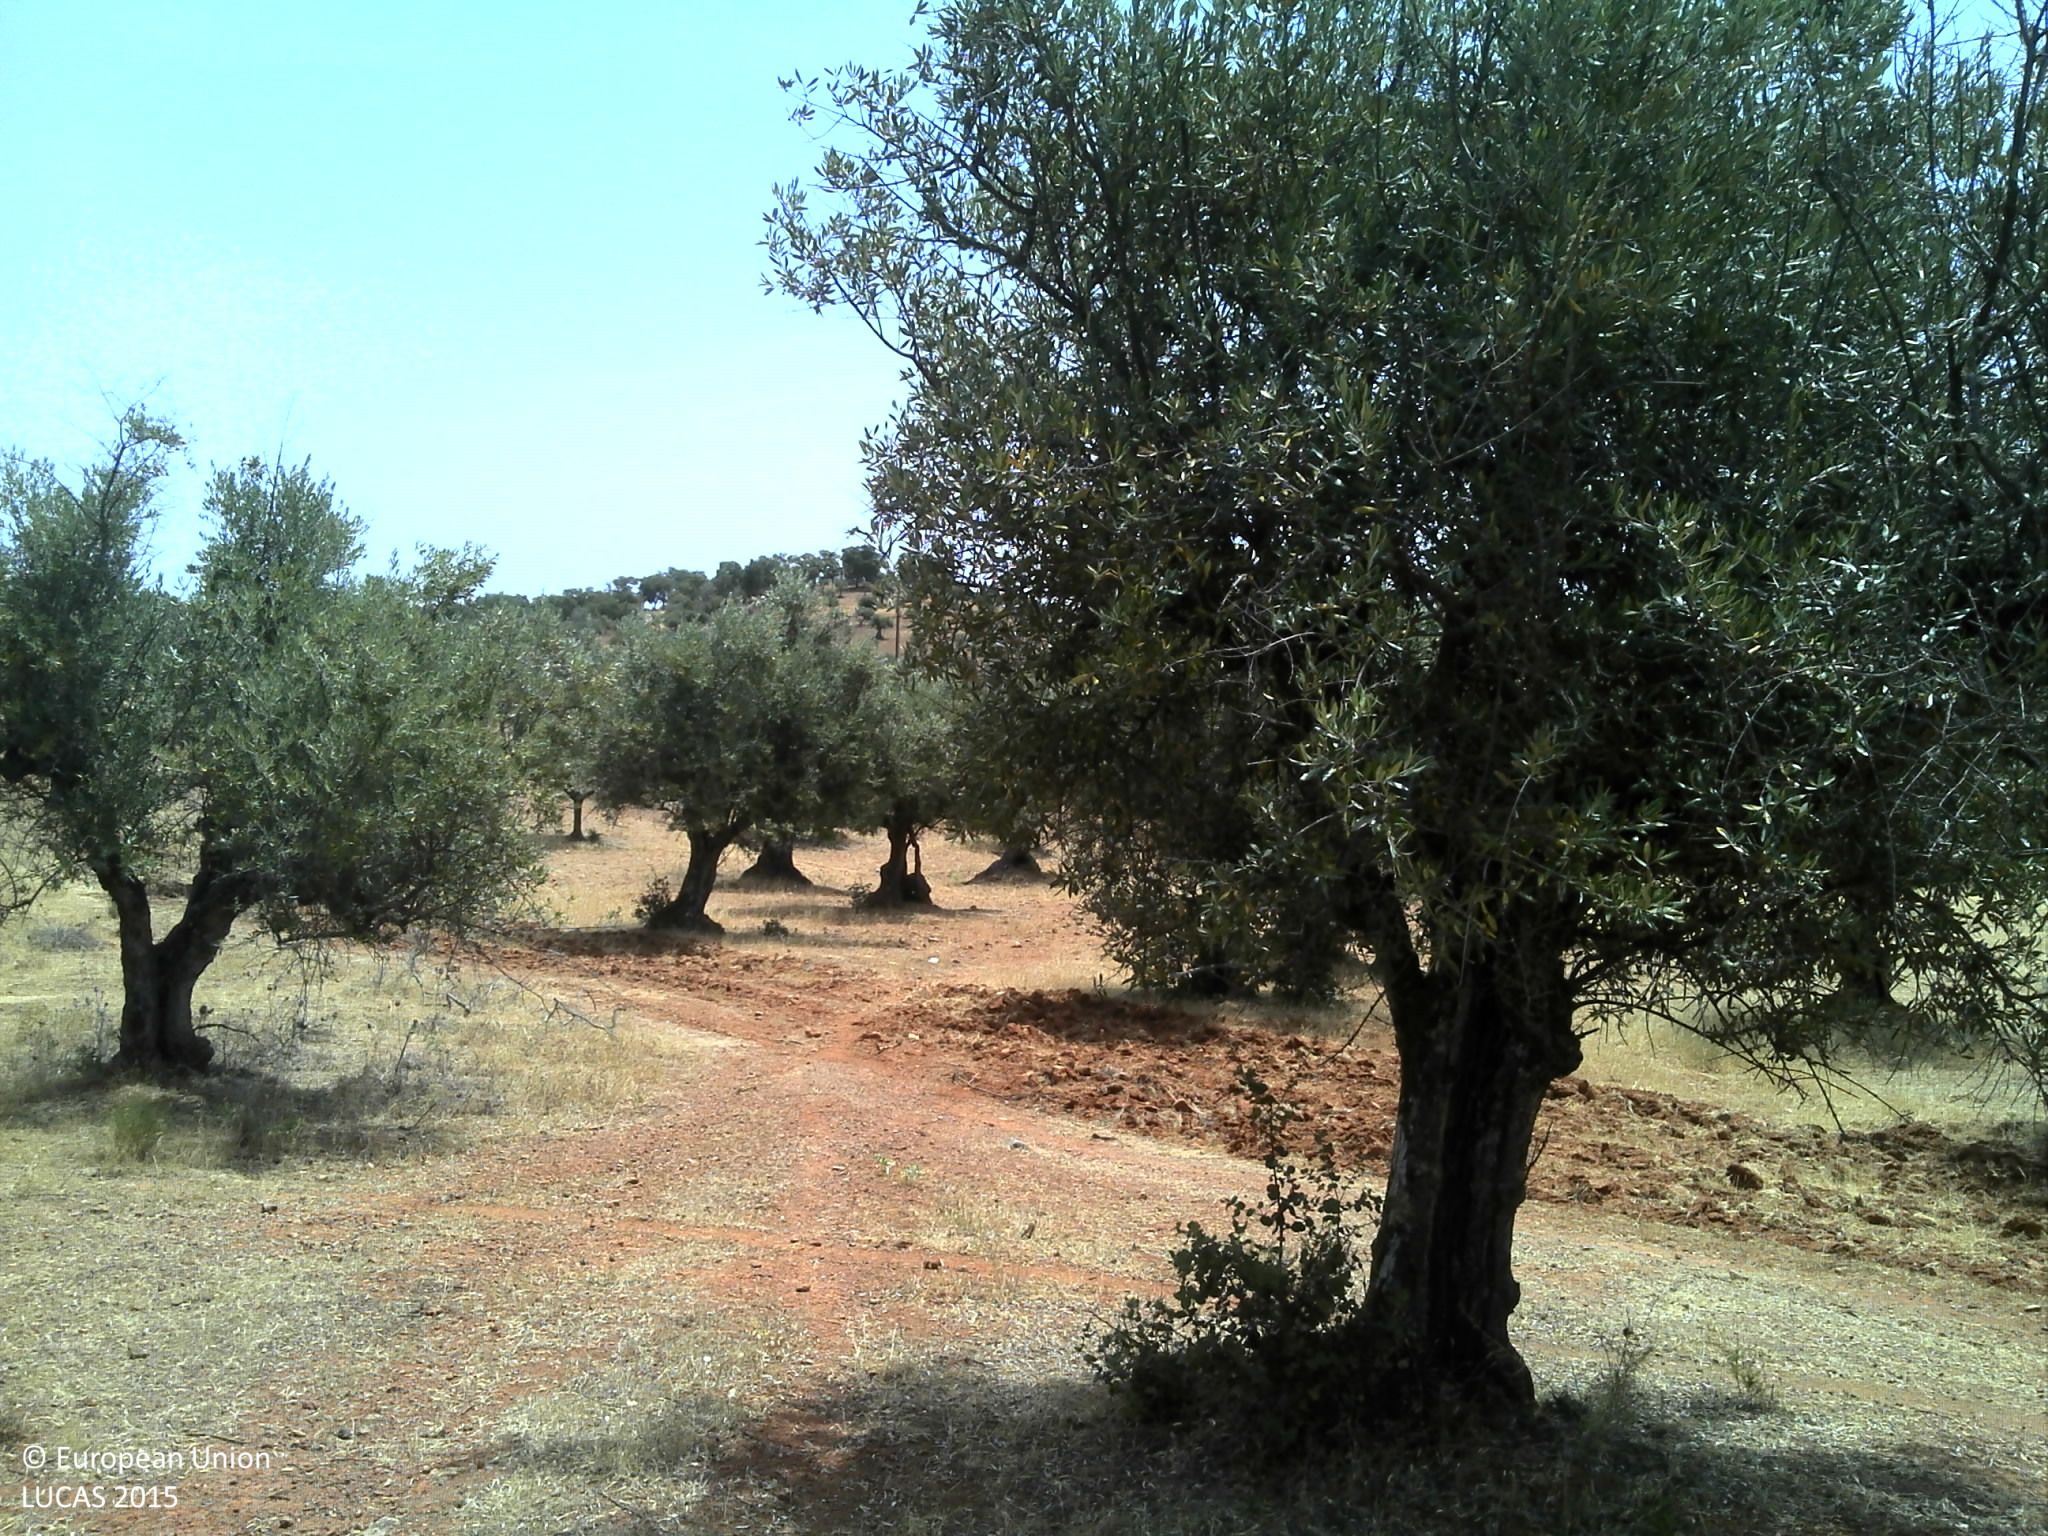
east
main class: Cropland
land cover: Olive groves
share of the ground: 25 - 50 %
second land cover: Grassland without tree/shrub cover
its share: 25 - 50 %
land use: Agriculture (excluding fallow land and kitchen gardens)
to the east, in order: Olive groves; Grassland without tree/shrub cover; Olive groves; Electric lines; Fences; Olive groves
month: July
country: PT
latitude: 38.2231
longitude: -7.6754
